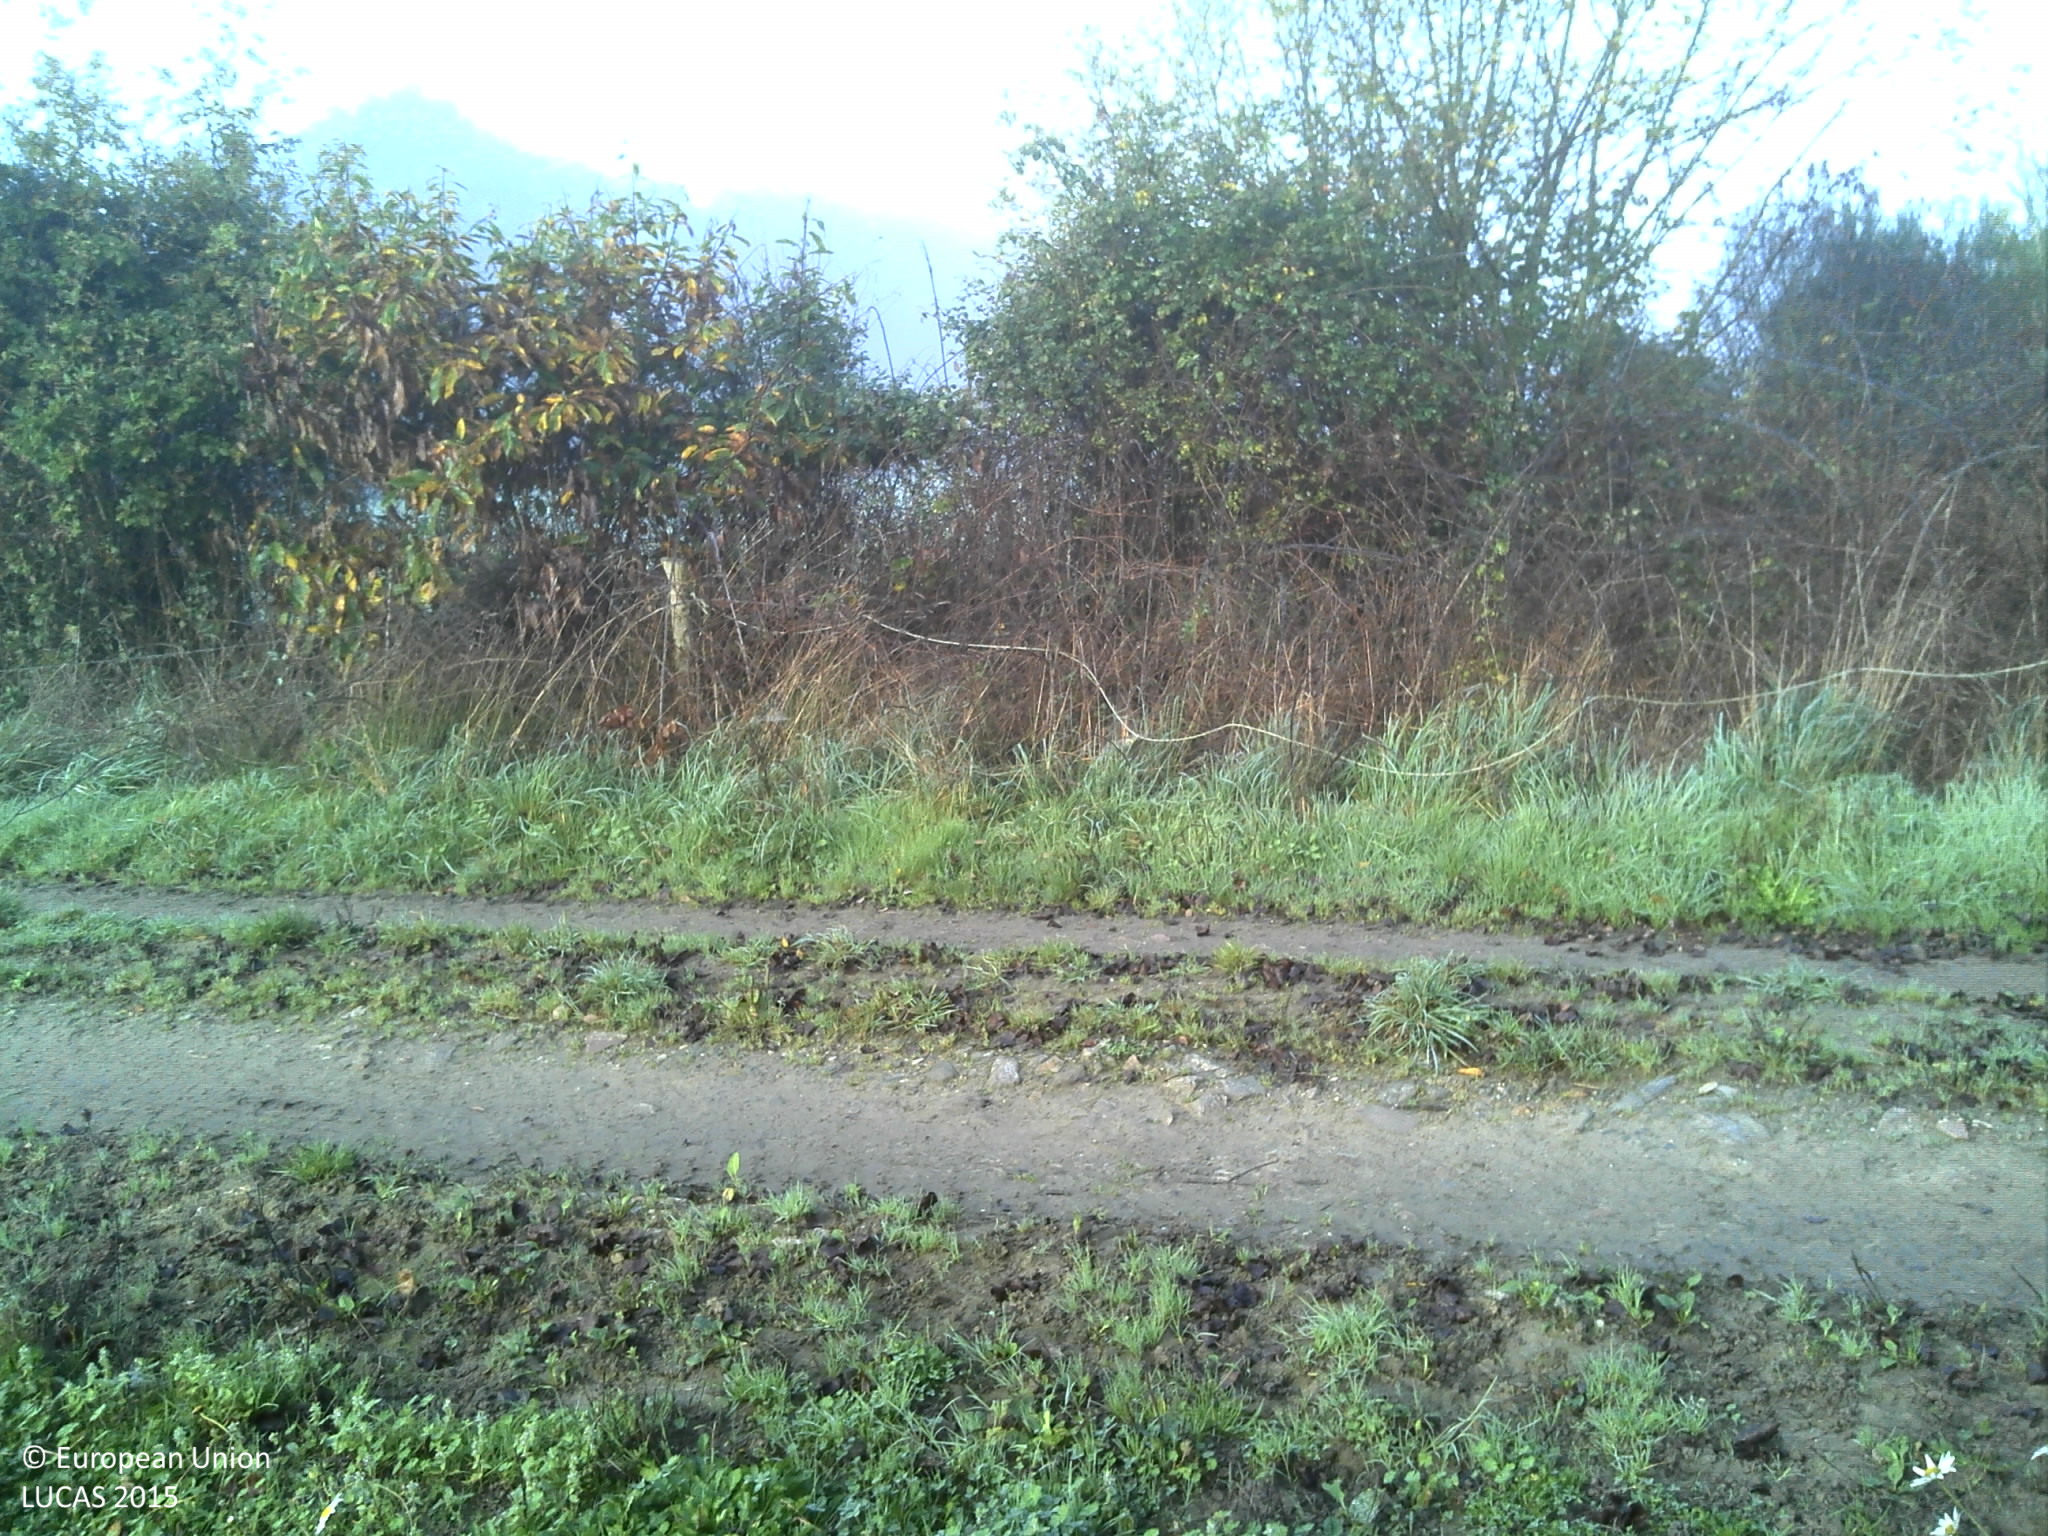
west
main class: Grassland
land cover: Grassland with sparse tree/shrub cover
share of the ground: > 75 %
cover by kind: herbaceous plants 95 %, coniferous forest trees 5 %
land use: Residential
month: November
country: FR
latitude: 47.3493
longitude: -1.8144
